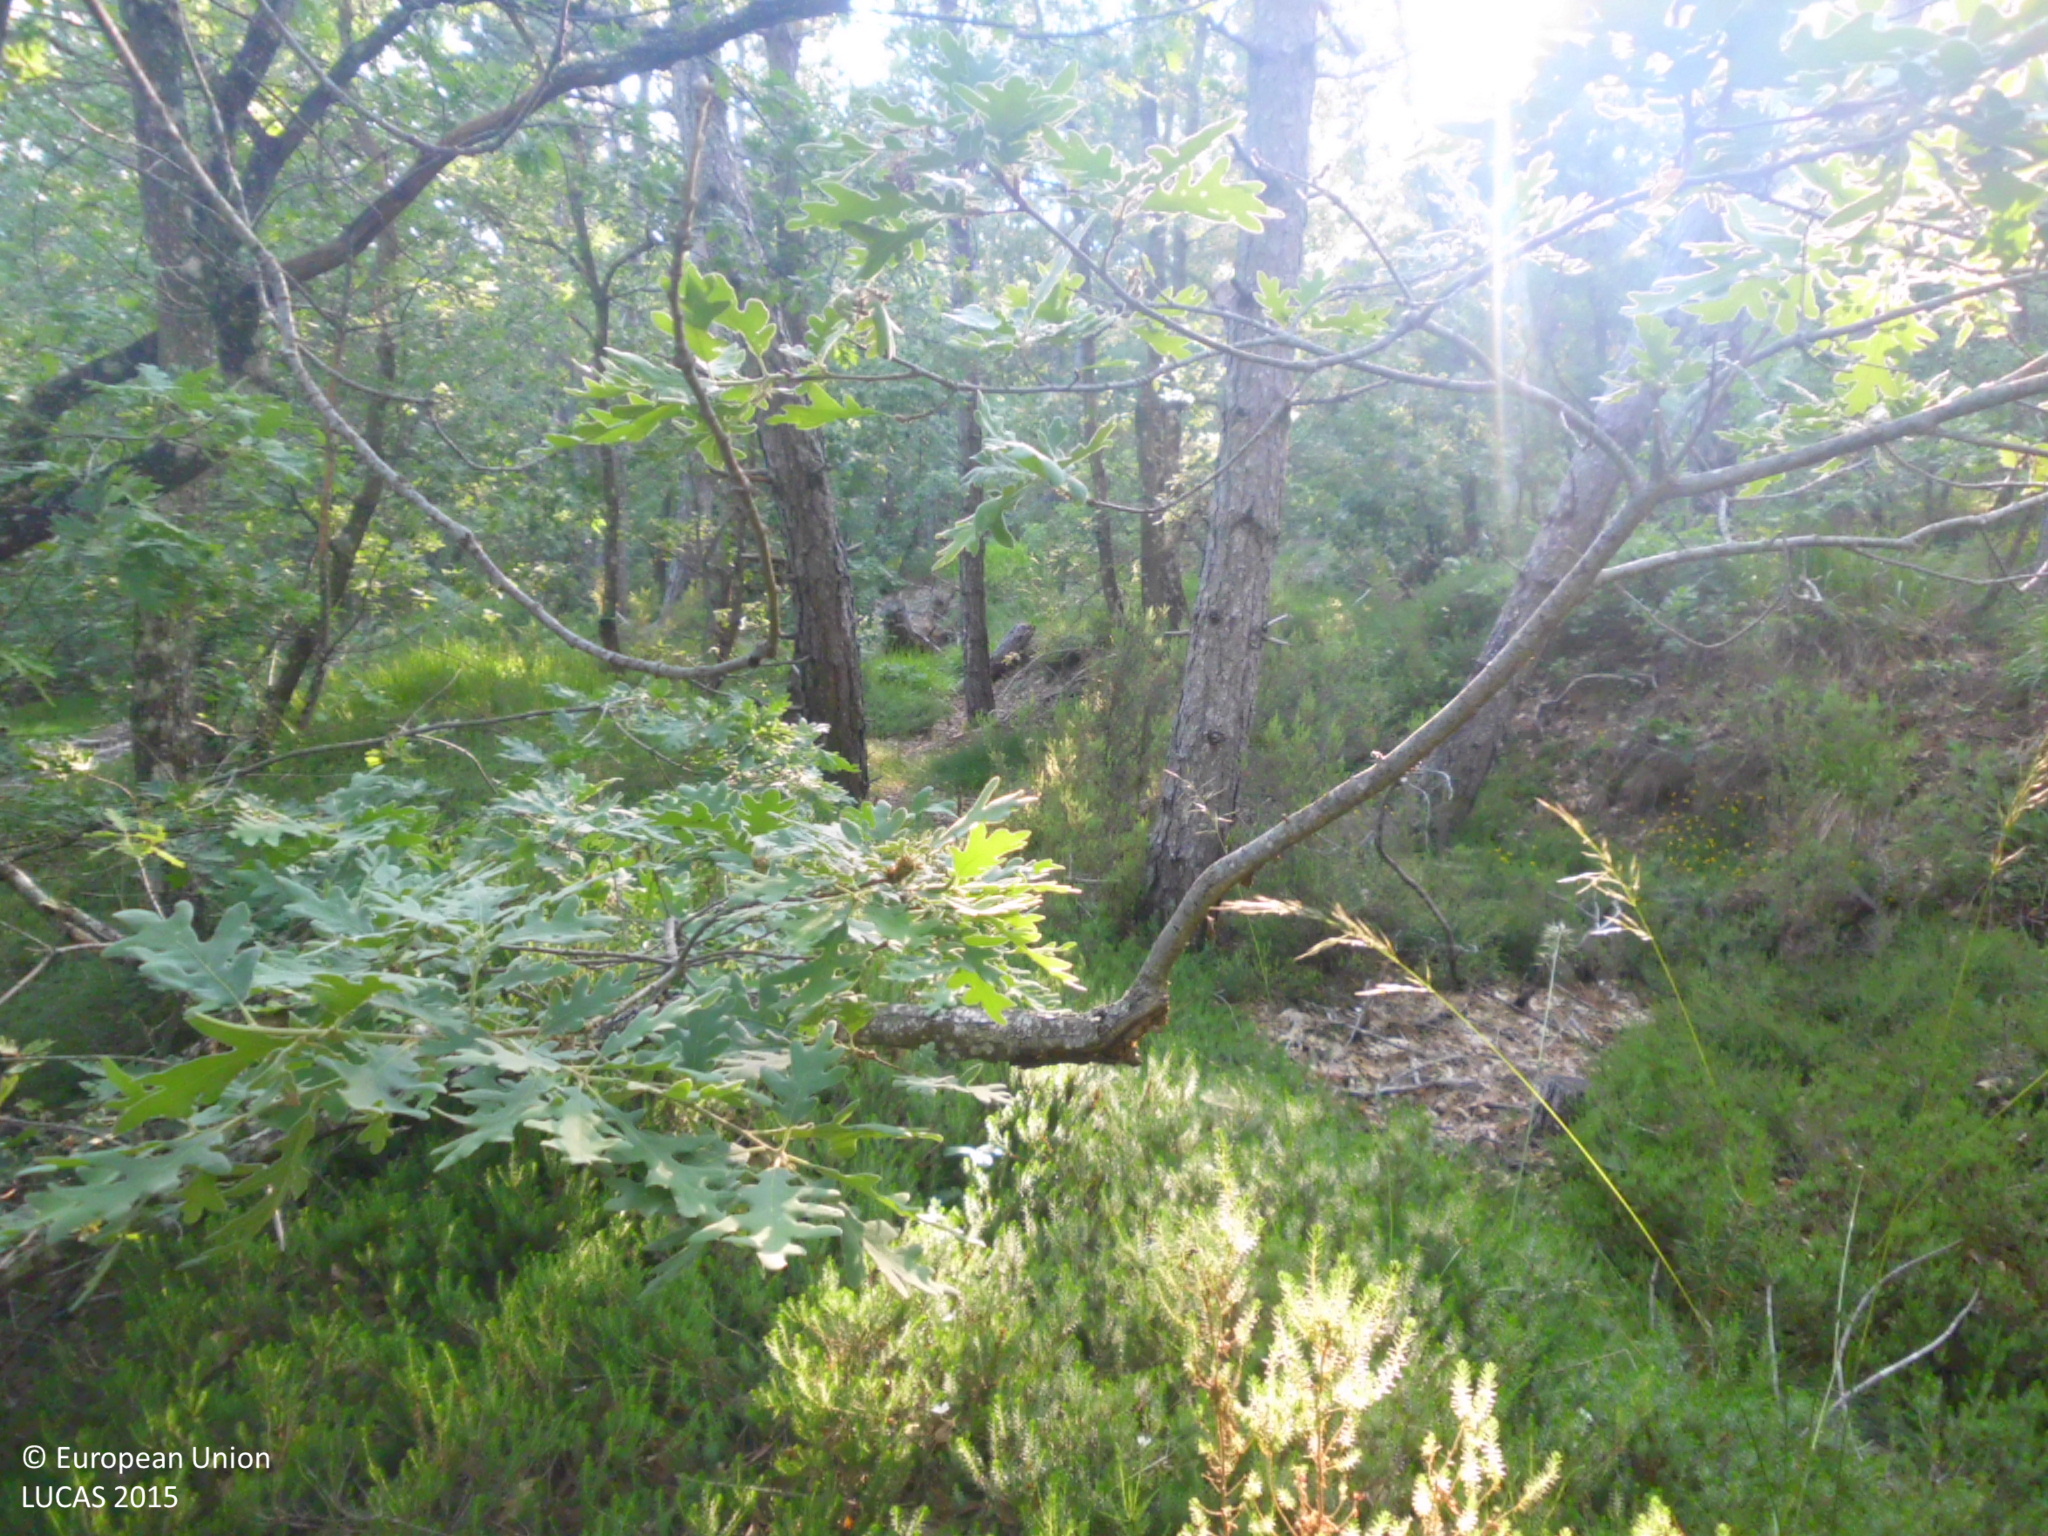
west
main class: Woodland
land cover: Pine dominated coniferous woodland
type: coniferous forest of the mediterranean region
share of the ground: > 75 %
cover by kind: coniferous forest trees 65 %, herbaceous plants 20 %, broadleaved forest trees 10 %, consolidated bare surface 5 %
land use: Forestry
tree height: > 5 m
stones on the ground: 25 - 50 %
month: June
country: ES
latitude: 42.3478
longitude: -3.3724
